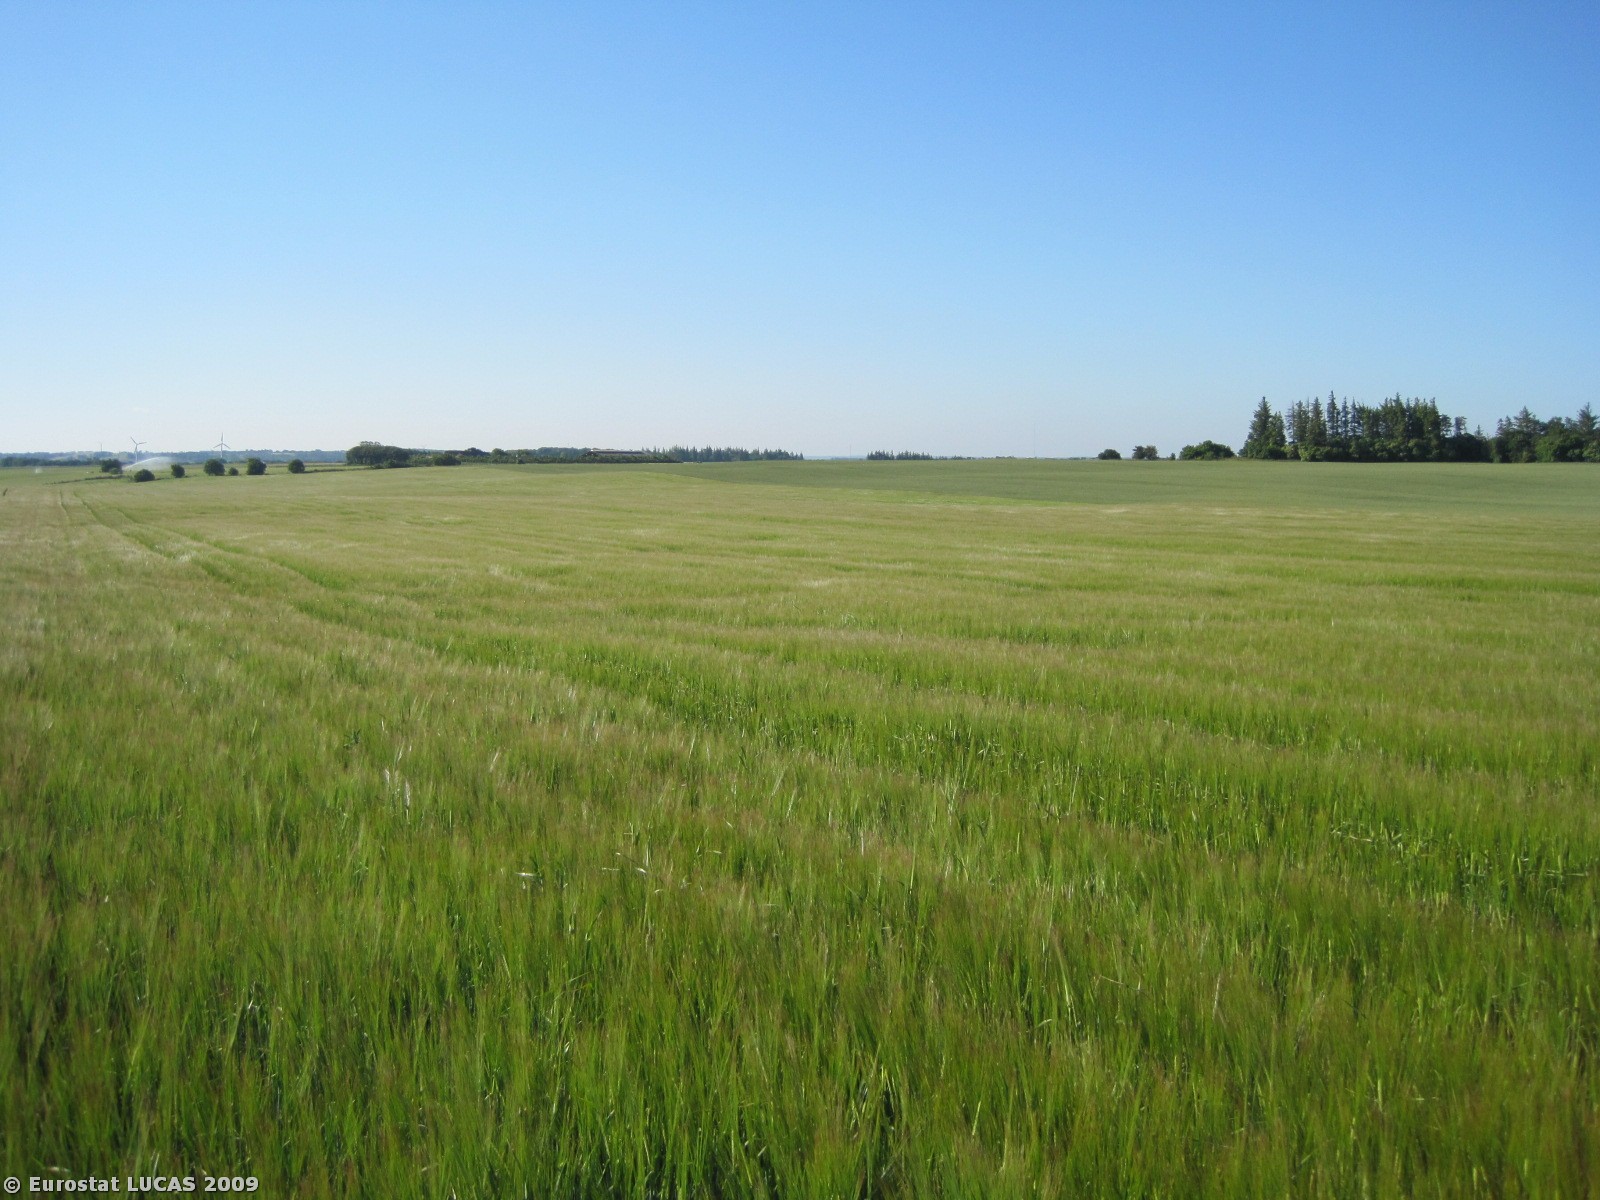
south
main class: Cropland
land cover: Barley
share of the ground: > 75 %
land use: Agriculture (excluding fallow land and kitchen gardens)
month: June
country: DK
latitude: 56.5808
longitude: 9.2033
